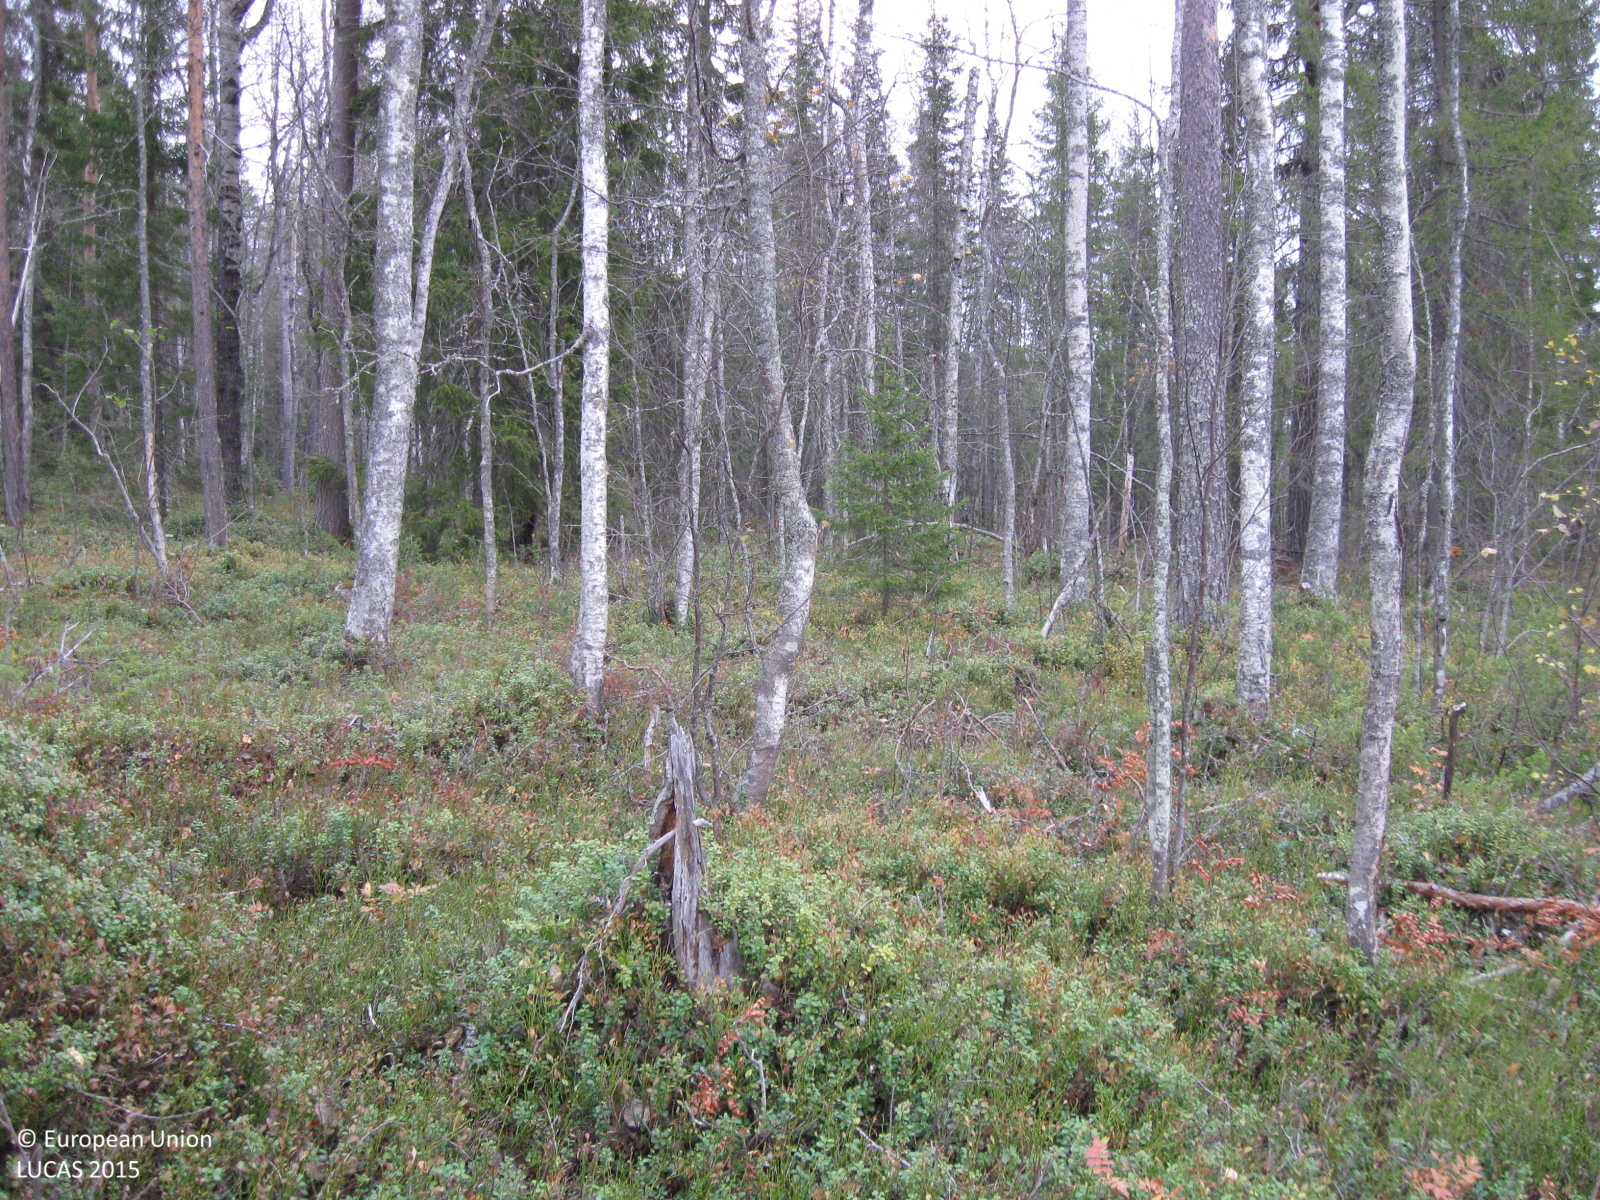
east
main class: Woodland
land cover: Broadleaved woodland
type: non-riverine alder, birch or aspen forest
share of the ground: > 75 %
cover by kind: broadleaved forest trees 75 %, herbaceous plants 10 %, coniferous forest trees 5 %, shrubs 5 %, lichens and mosses 5 %
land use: Forestry
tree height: > 5 m
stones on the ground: < 10 %
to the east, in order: Broadleaved woodland; Pine dominated mixed woodland; Spruce dominated mixed woodland; Pine dominated mixed woodland; Peatbogs; Single bushes/trees; Peatbogs; Pine dominated mixed woodland
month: October
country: SE
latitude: 66.0601
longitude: 22.0980
